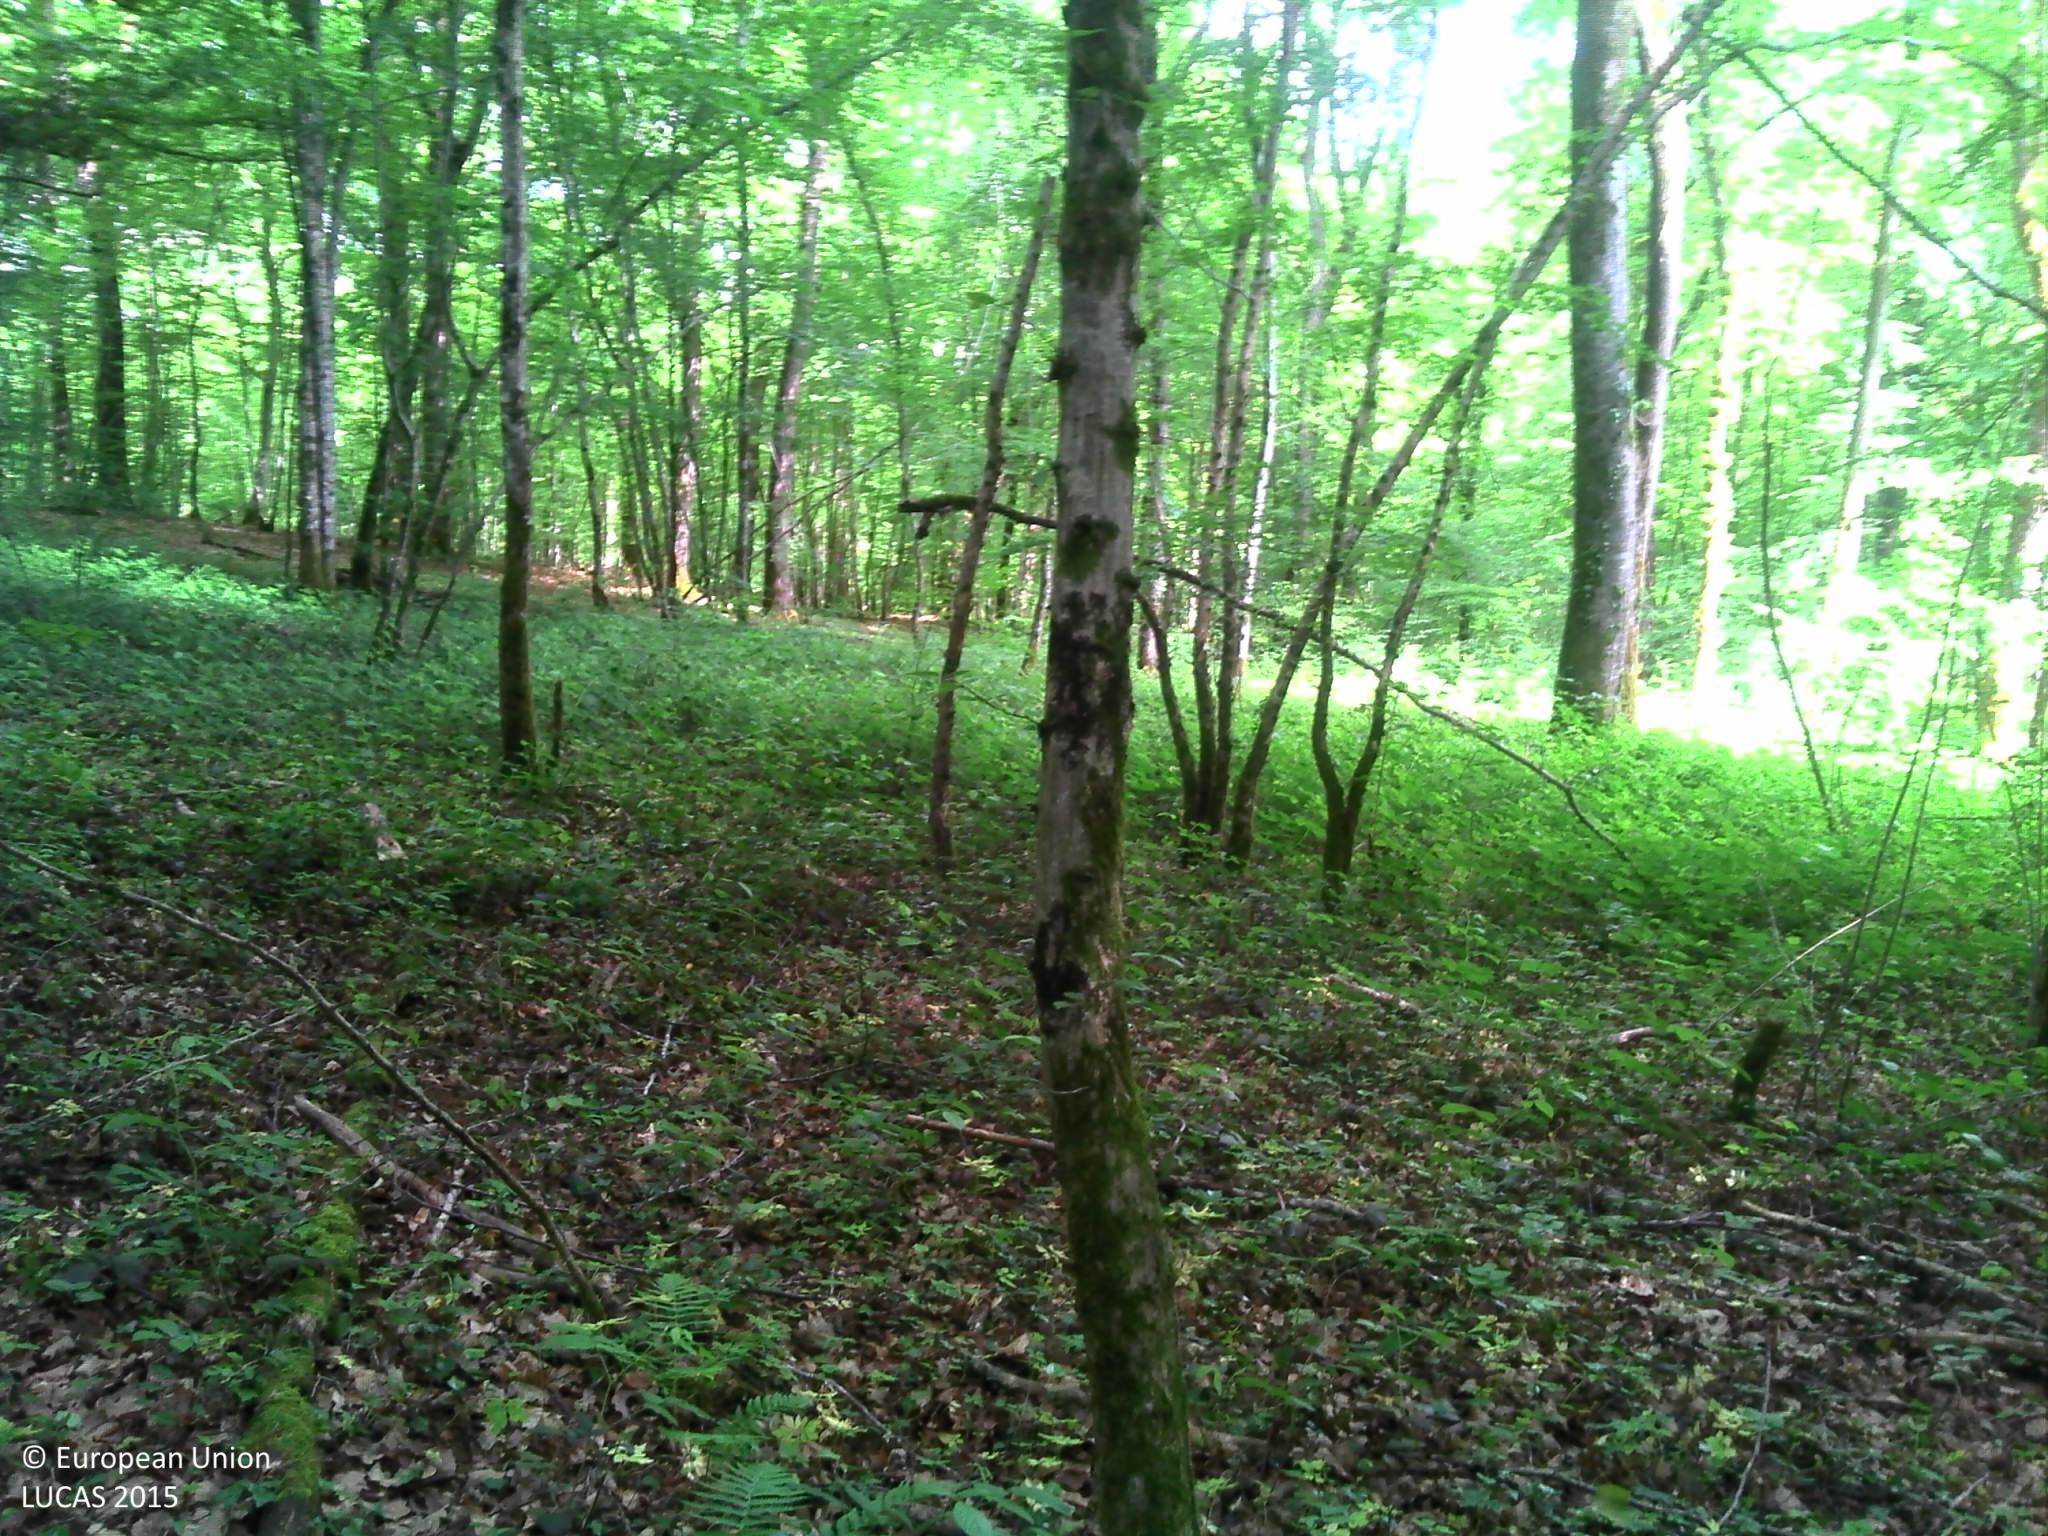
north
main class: Woodland
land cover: Broadleaved woodland
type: beech forest
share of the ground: > 75 %
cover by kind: broadleaved forest trees 95 %, herbaceous plants 5 %
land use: Forestry
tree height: > 5 m
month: May
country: FR
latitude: 47.6412
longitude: 5.4082
